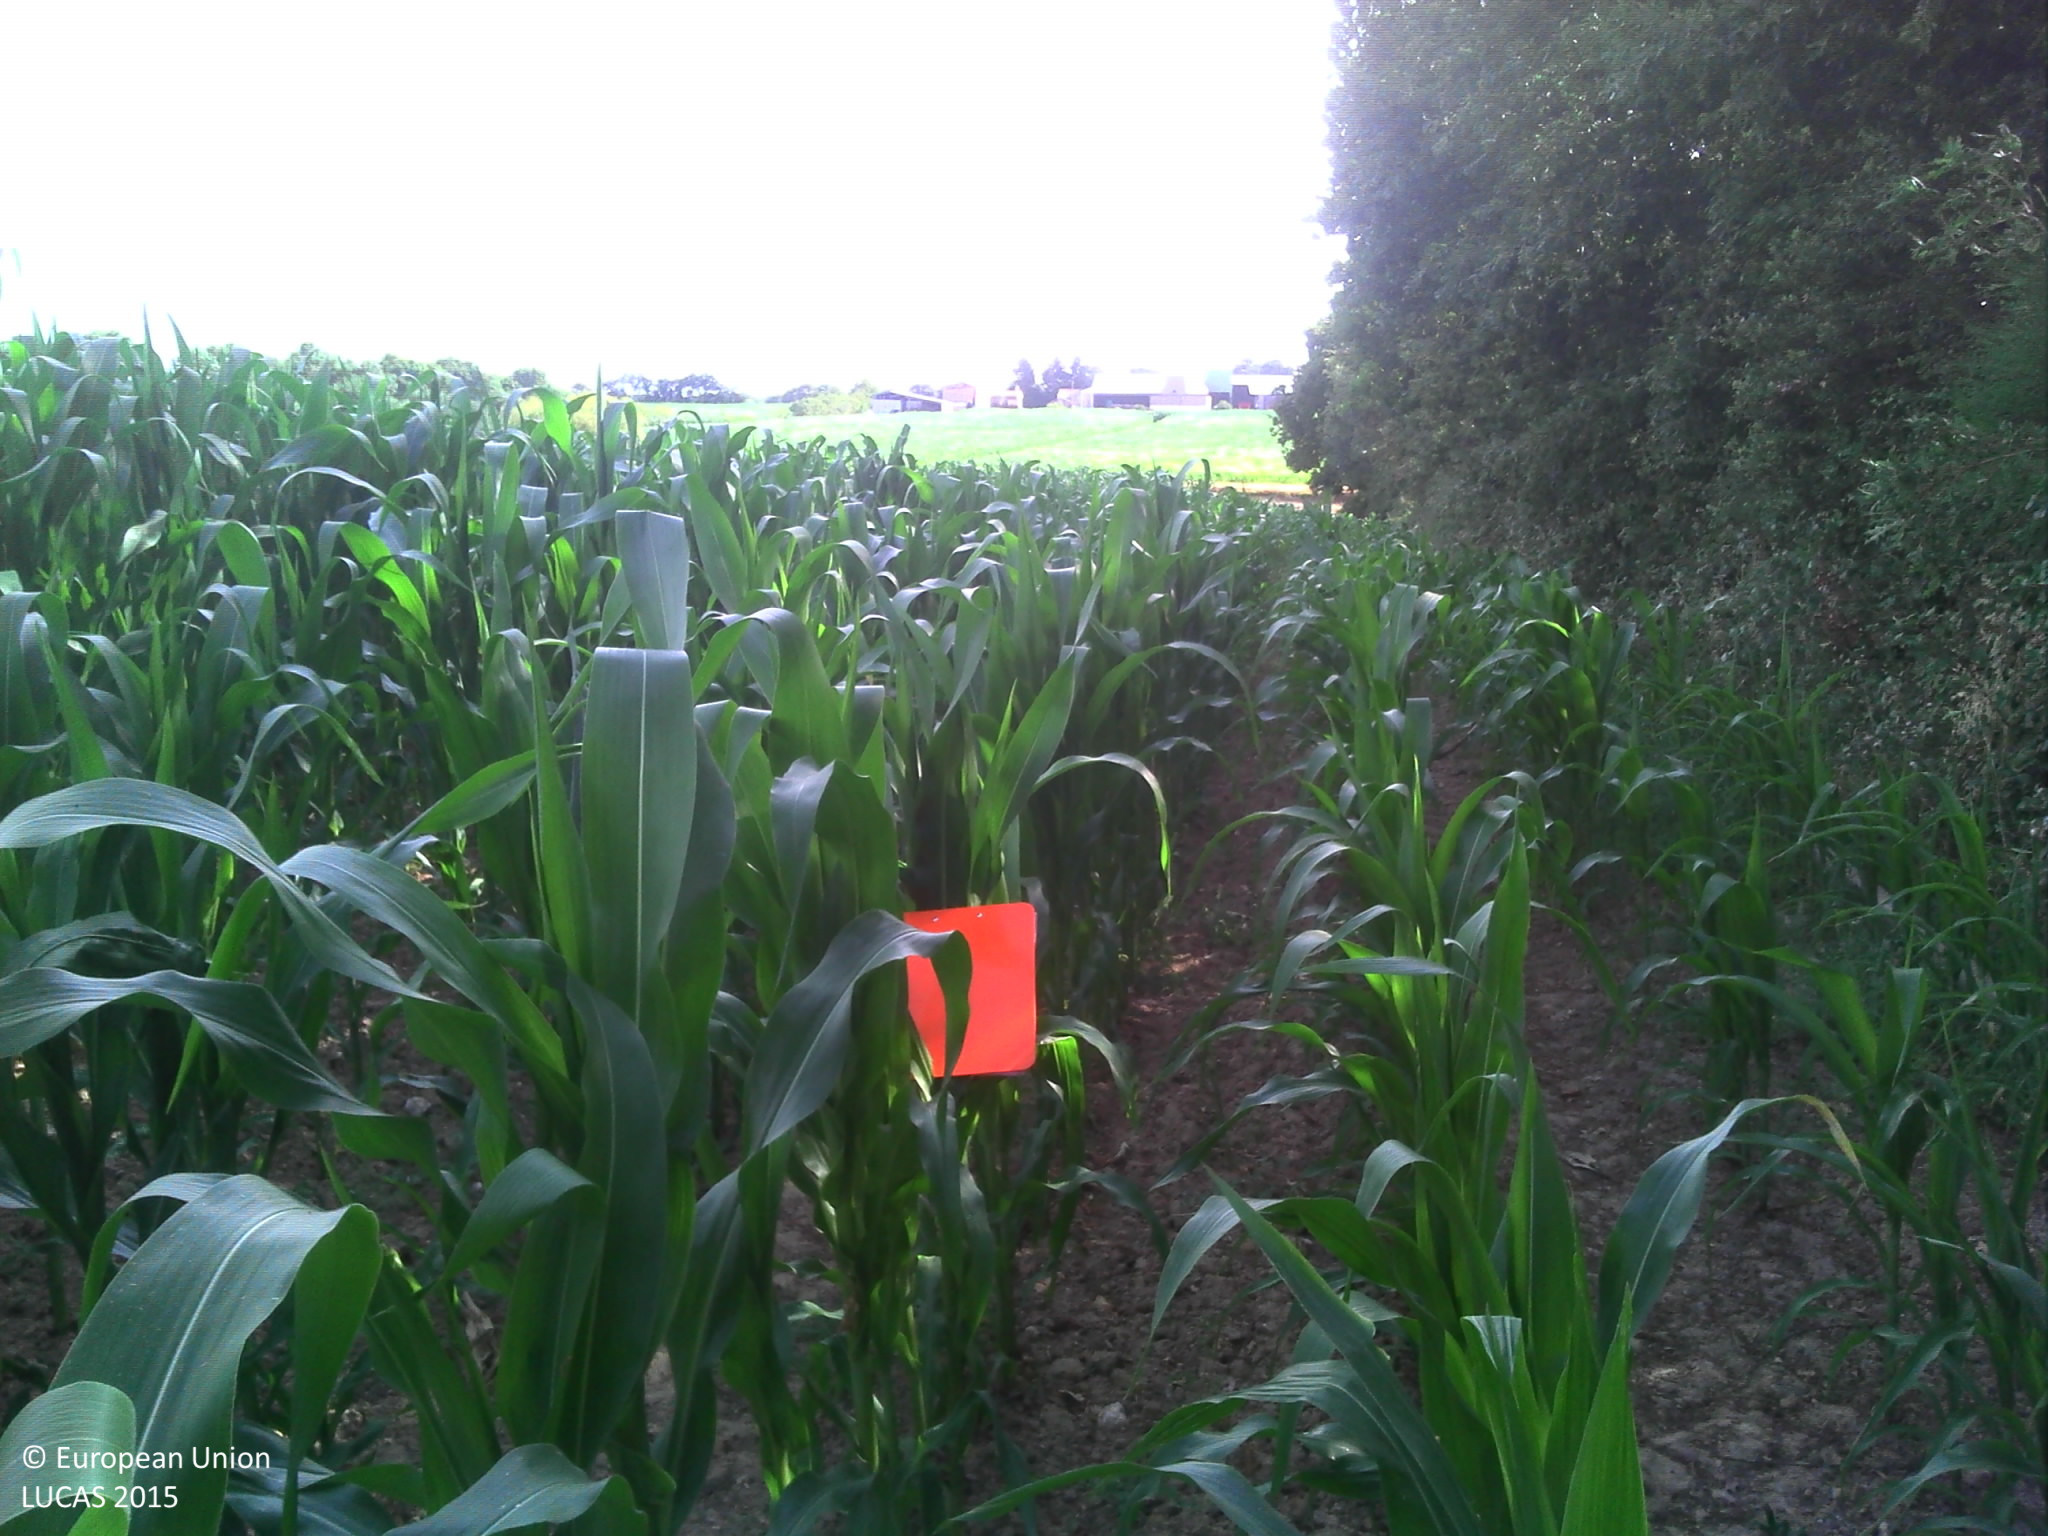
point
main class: Cropland
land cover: Maize
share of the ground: > 75 %
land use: Agriculture (excluding fallow land and kitchen gardens)
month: July
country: FR
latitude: 46.5179
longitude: -1.6008
